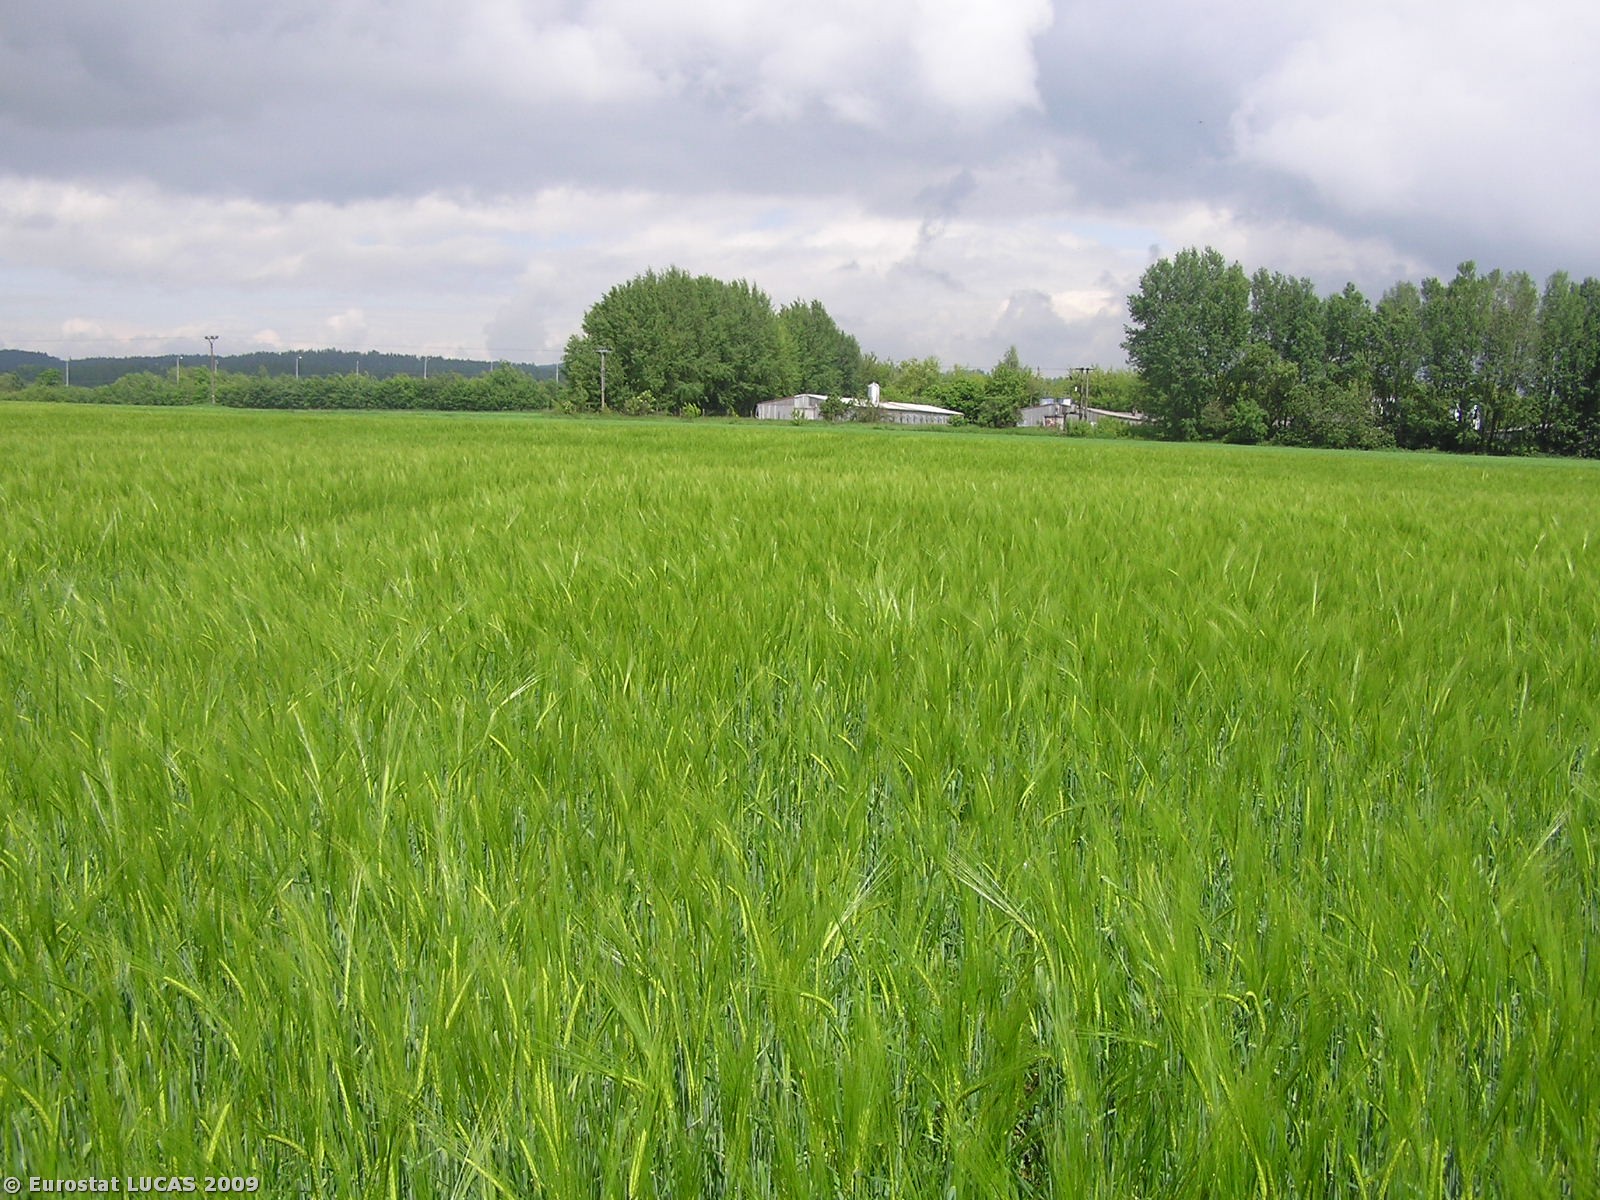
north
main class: Cropland
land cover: Barley
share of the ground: > 75 %
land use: Agriculture (excluding fallow land and kitchen gardens)
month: May
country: CZ
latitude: 49.4432
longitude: 14.5943
